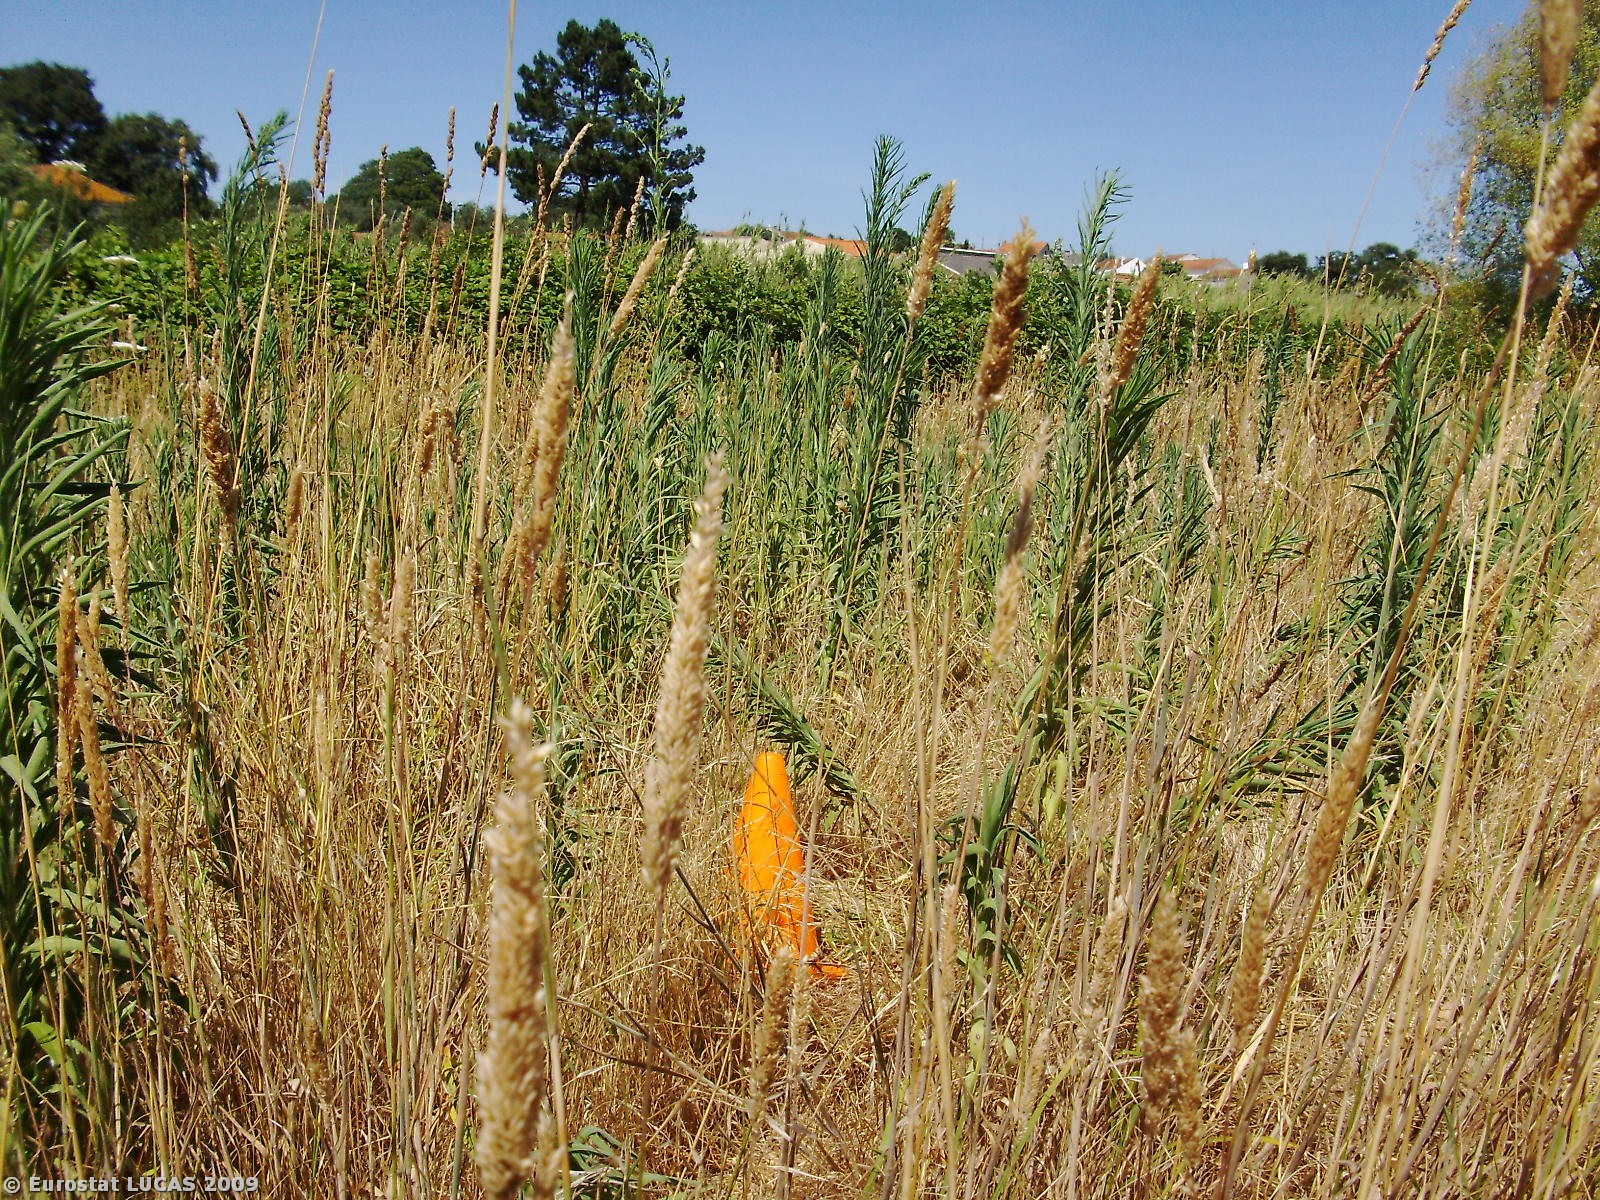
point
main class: Grassland
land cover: Spontaneously vegetated surfaces
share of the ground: > 75 %
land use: Fallow land
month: July
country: PT
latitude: 39.6769
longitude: -8.8683
